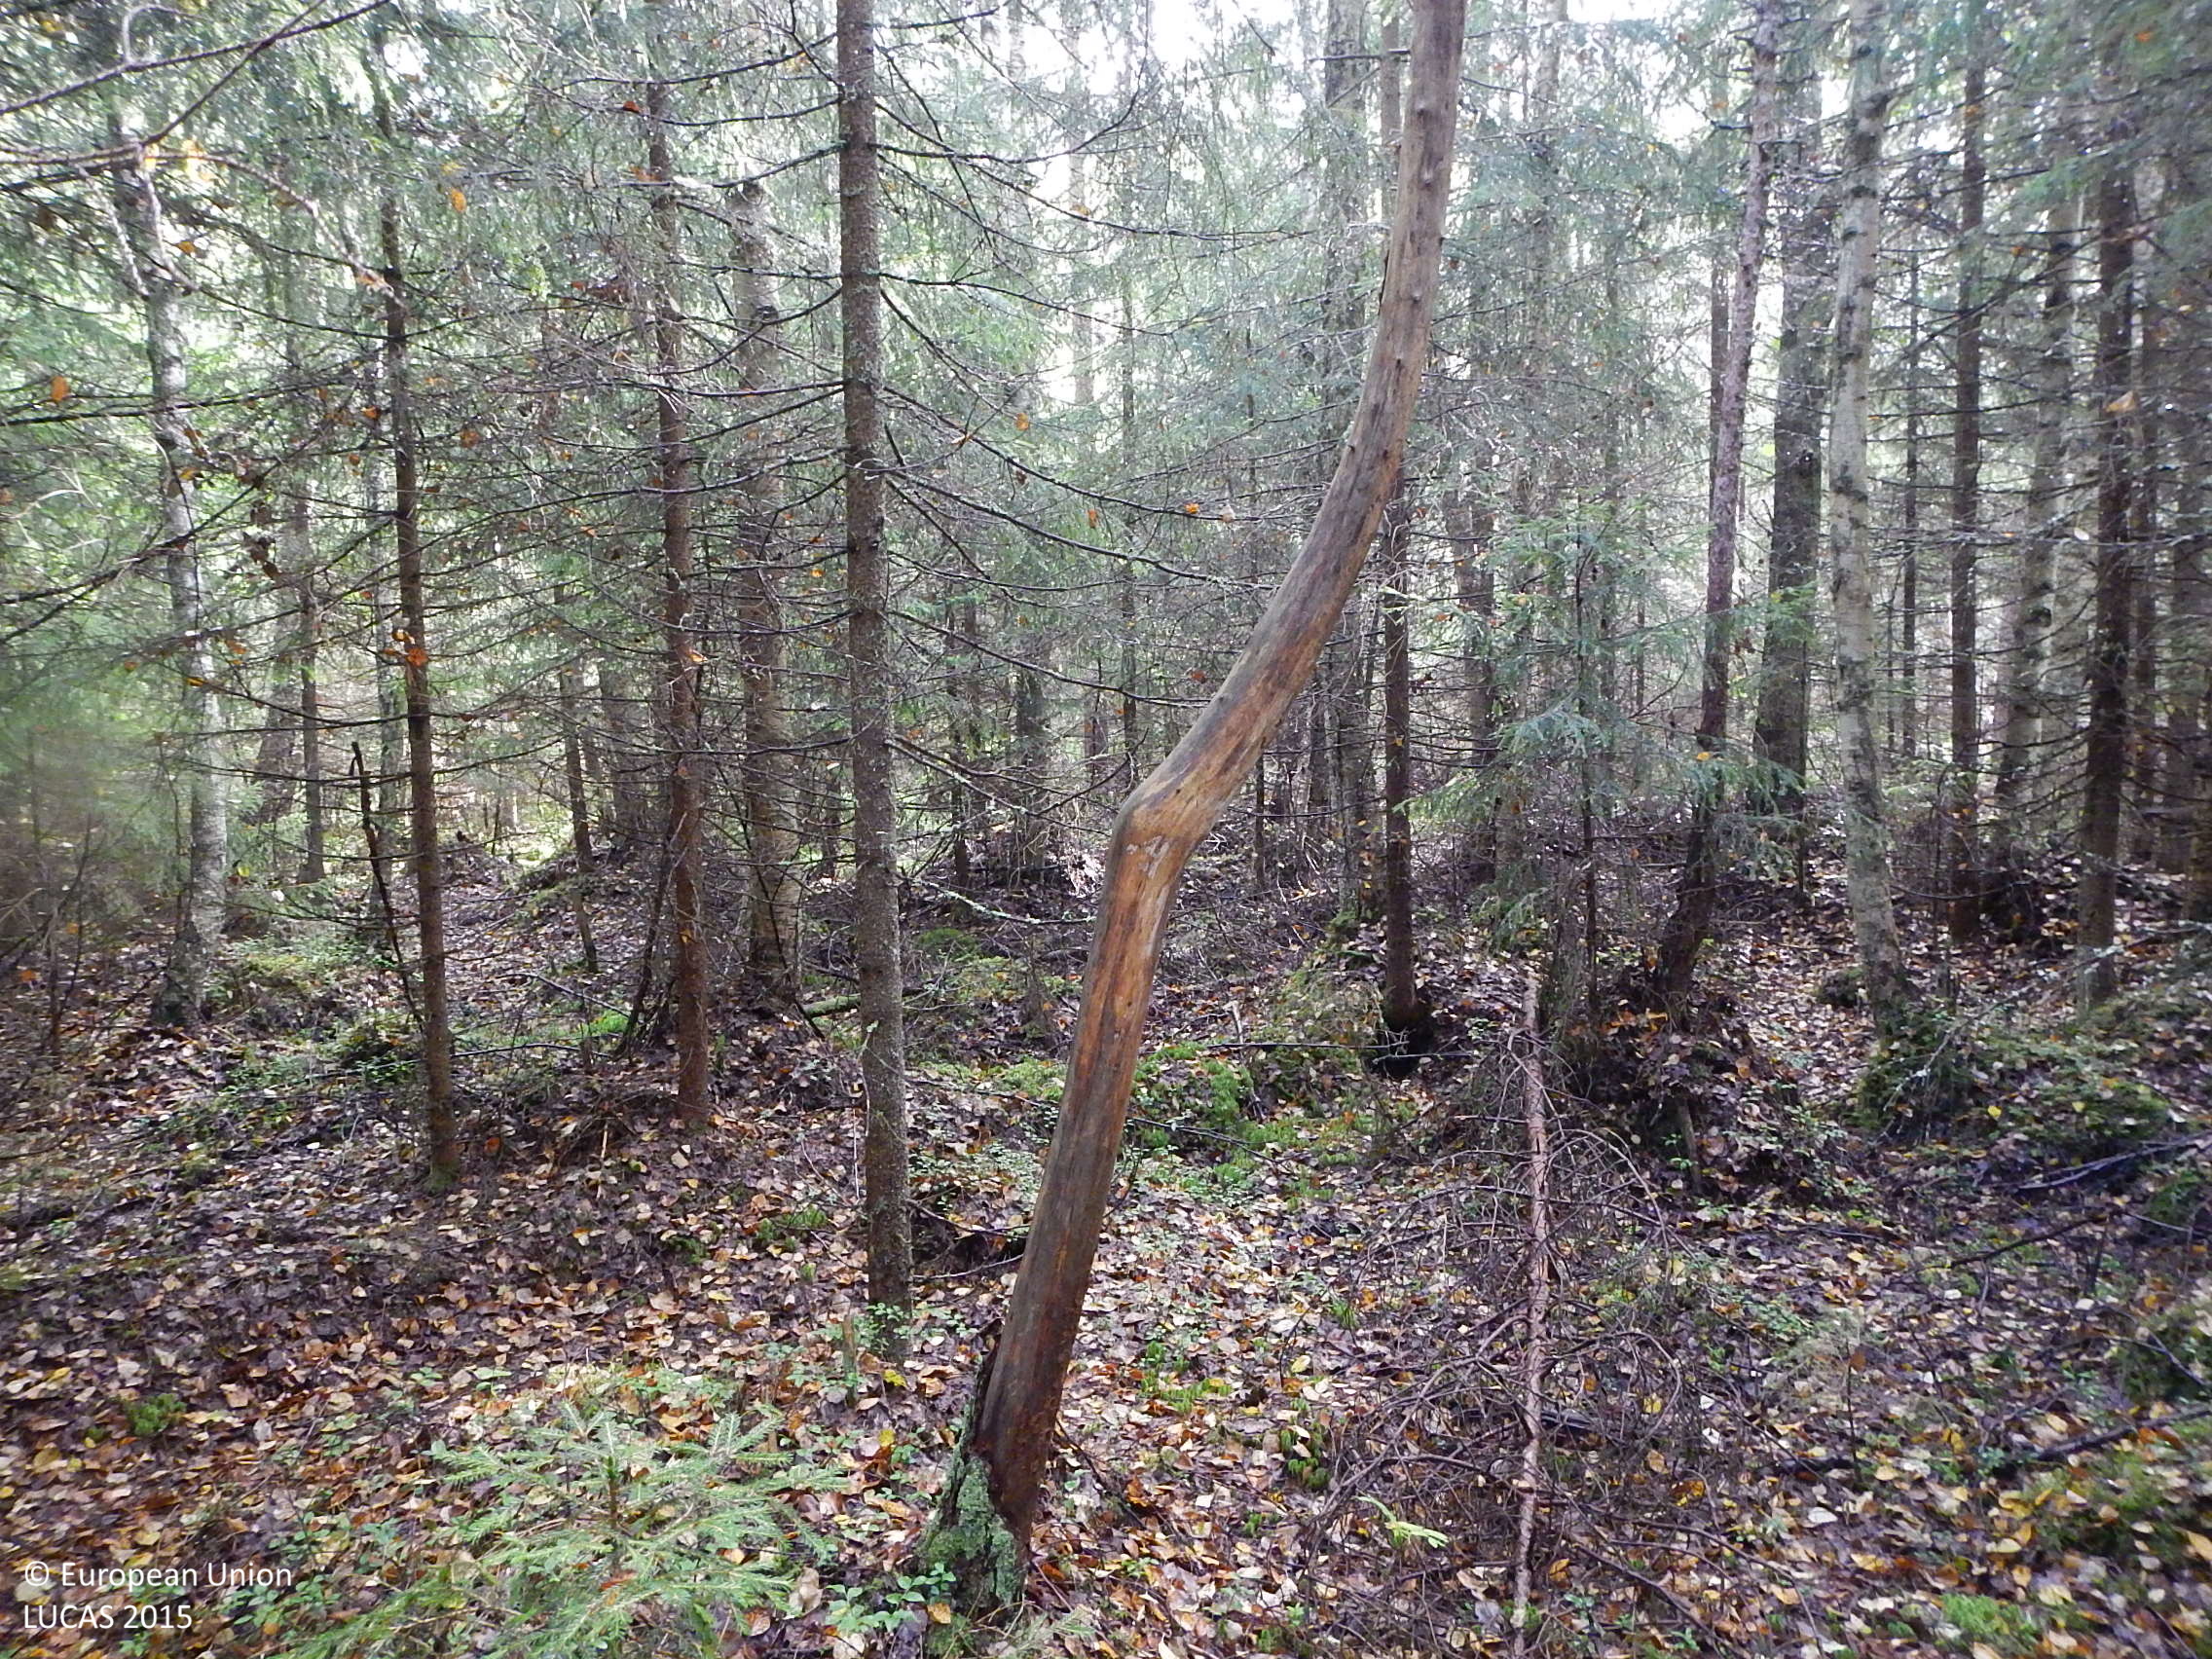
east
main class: Woodland
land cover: Other mixed woodland
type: boreal forest
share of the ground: > 75 %
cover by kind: coniferous forest trees 50 %, broadleaved forest trees 25 %, shrubs 10 %, unconsolidated bare surface 10 %, lichens and mosses 5 %
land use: Forestry
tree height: > 5 m
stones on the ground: 10 - 25 %
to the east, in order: Other mixed woodland; Ditches and canals; Other mixed woodland; Pine dominated coniferous woodland; Spruce dominated mixed woodland; Pine dominated mixed woodland
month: September
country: FI
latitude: 61.4148
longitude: 22.2575
